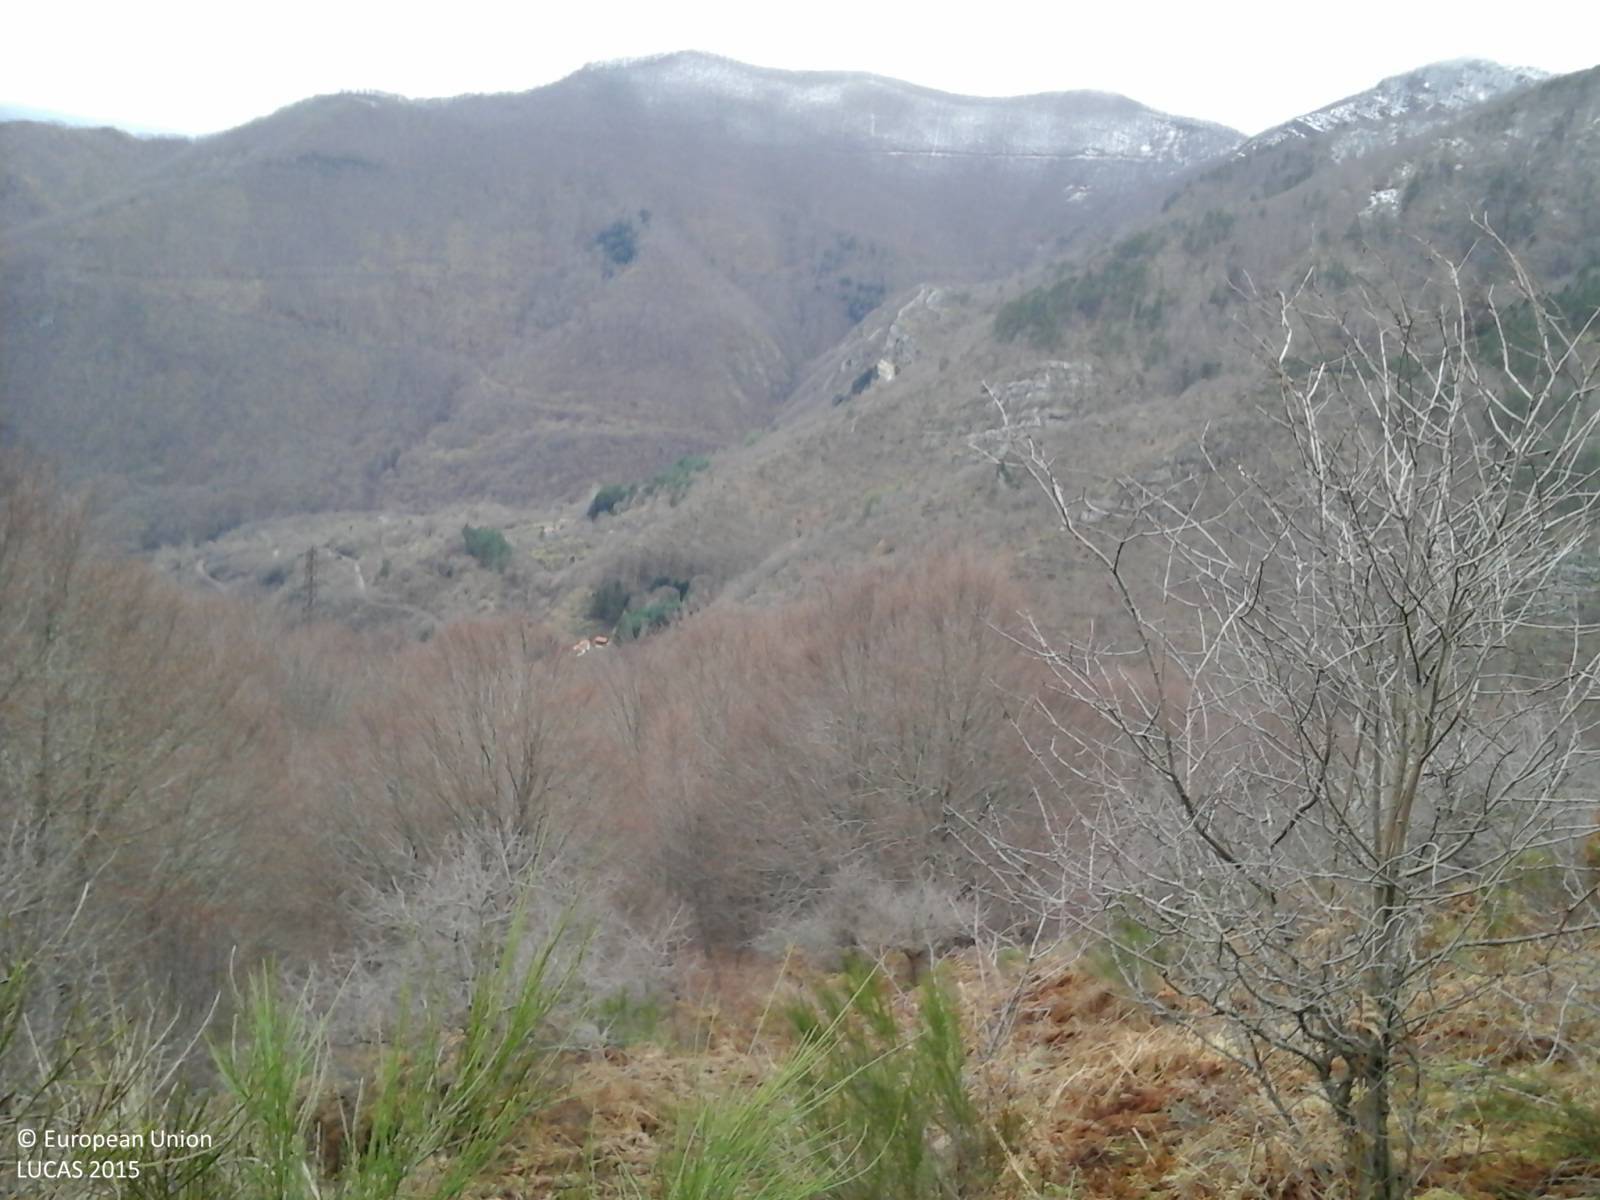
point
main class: Shrubland
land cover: Shrubland with sparse tree cover
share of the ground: > 75 %
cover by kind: shrubs 90 %, broadleaved forest trees 5 %, herbaceous plants 5 %
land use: Semi-natural and natural areas not in use
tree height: < 5 m
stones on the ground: 25 - 50 %
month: January
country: IT
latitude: 44.0962
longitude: 10.6106
